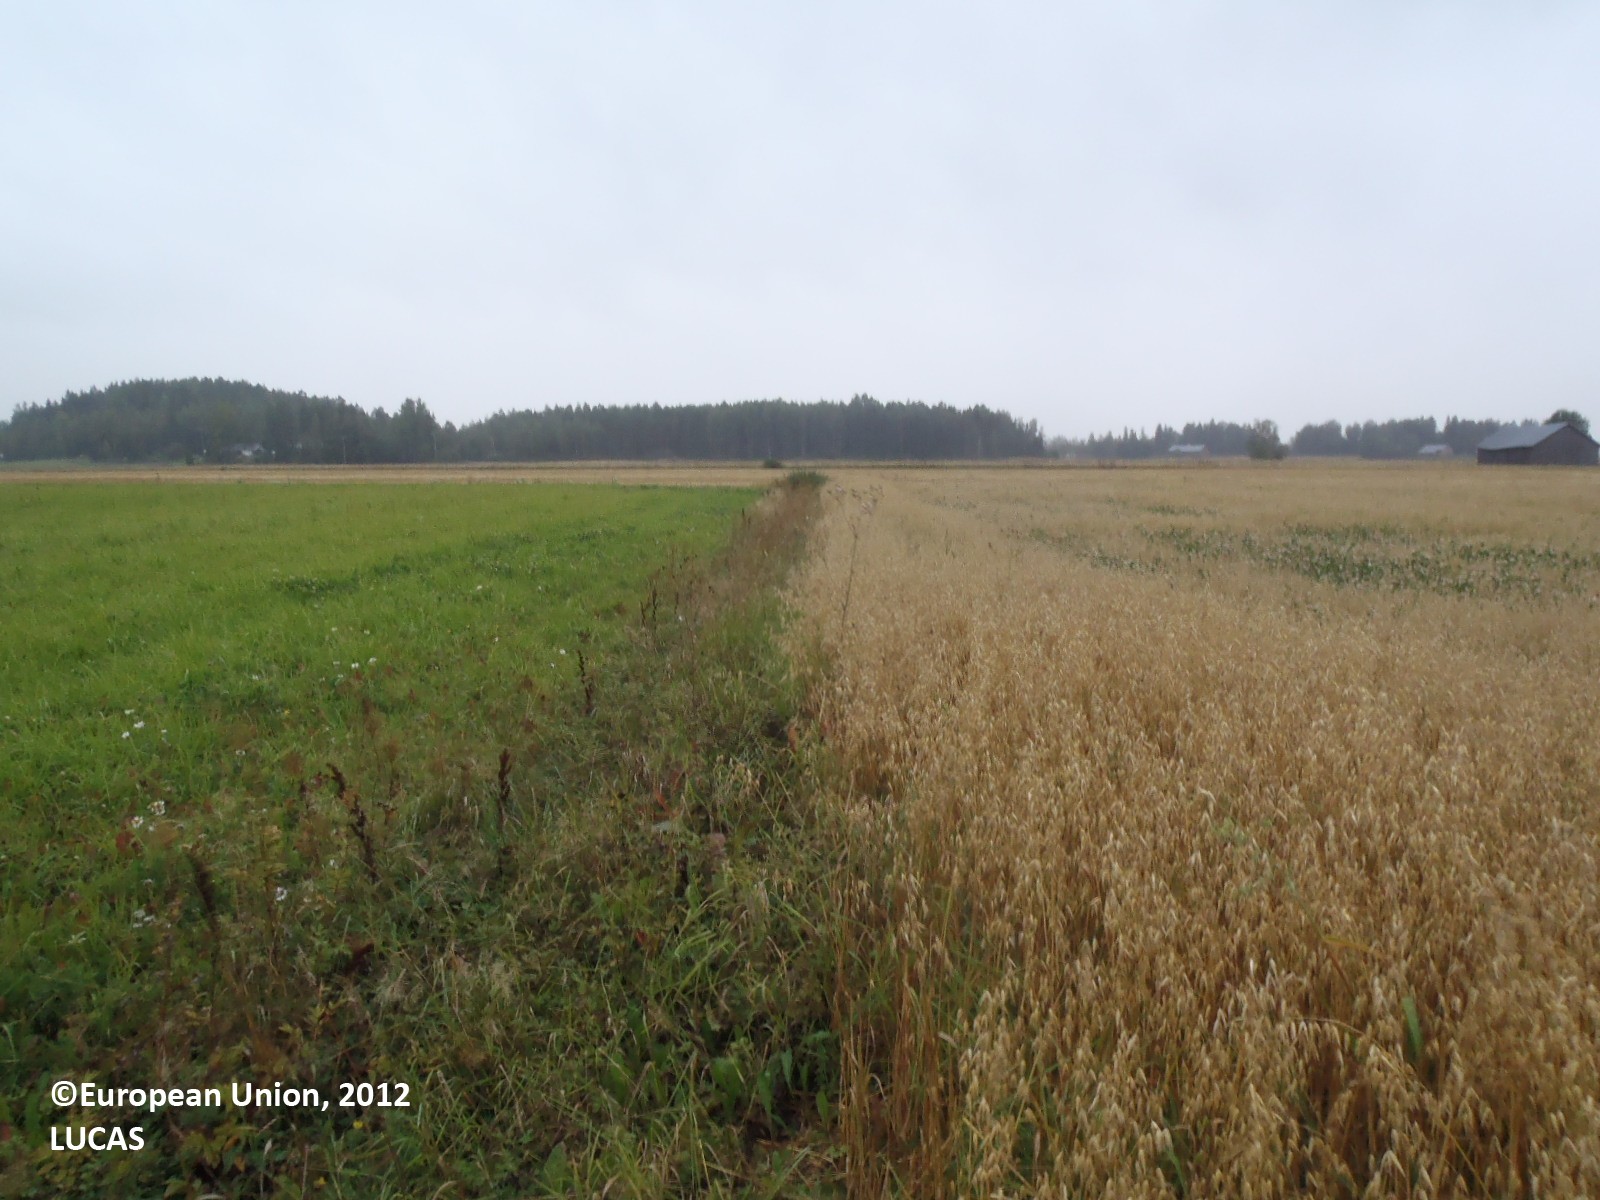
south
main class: Cropland
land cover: Oats
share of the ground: > 75 %
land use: Agriculture (excluding fallow land and kitchen gardens)
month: September
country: FI
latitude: 61.2499
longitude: 22.6855
